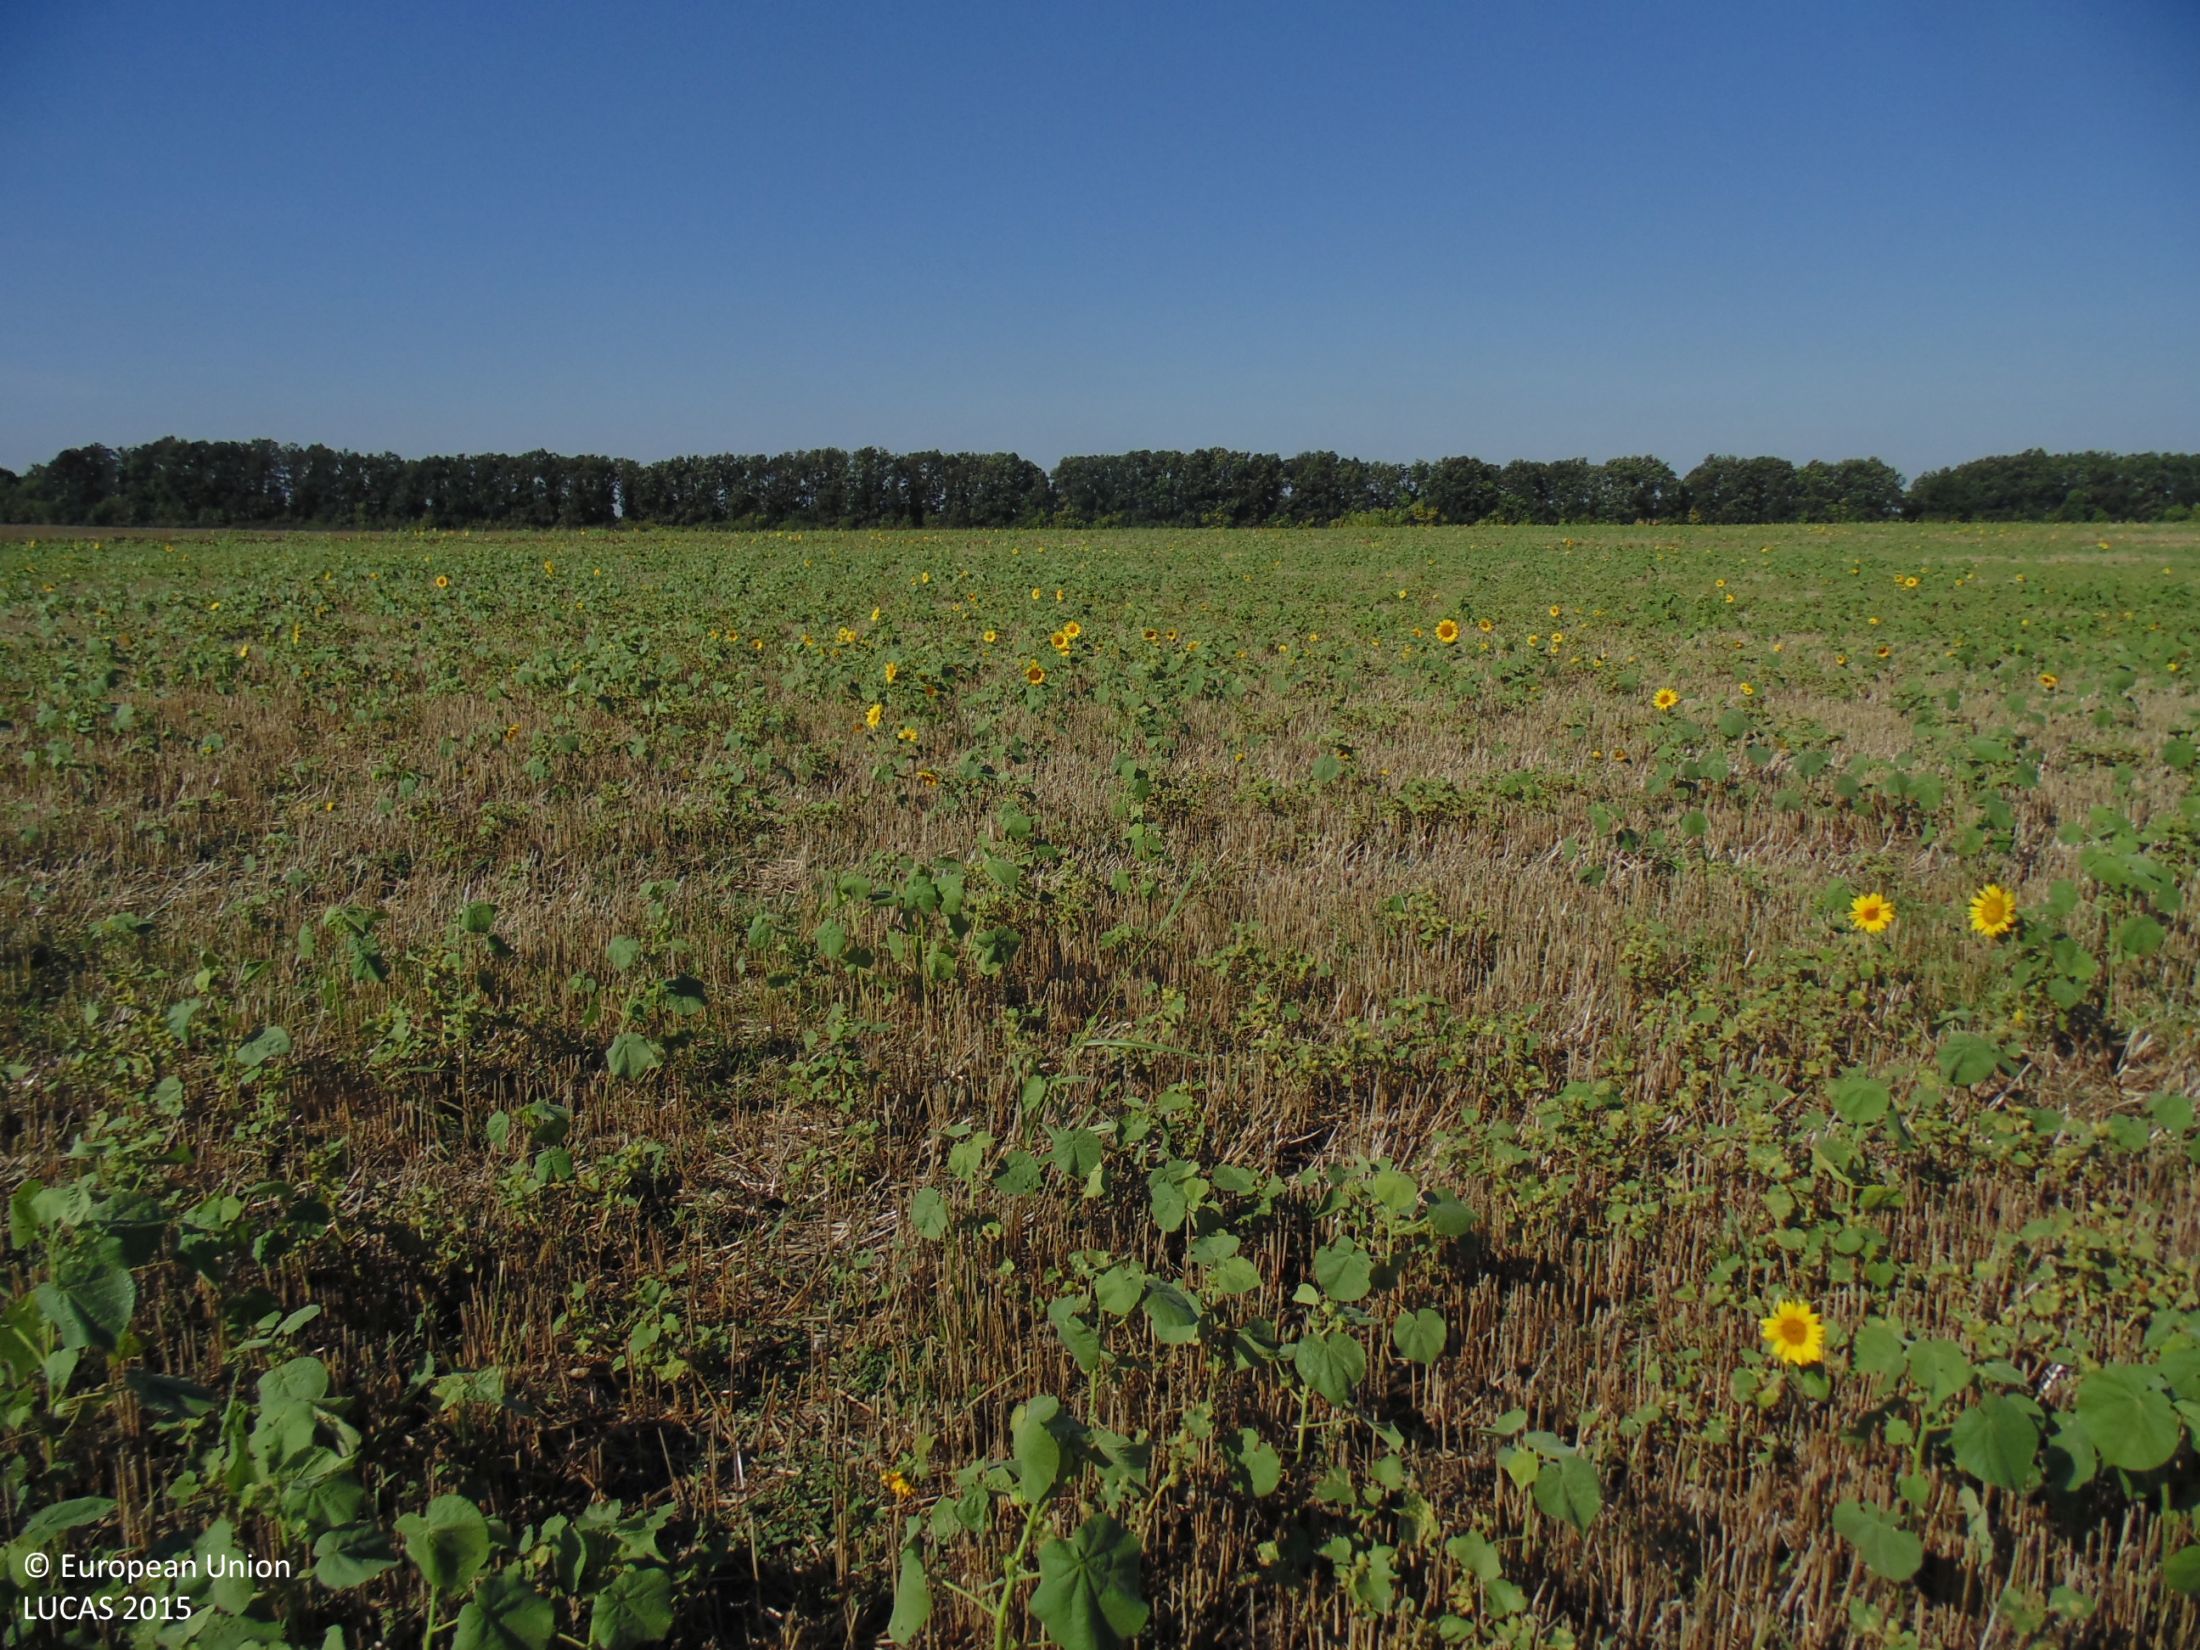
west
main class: Cropland
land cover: Common wheat
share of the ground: 10 - 25 %
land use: Agriculture (excluding fallow land and kitchen gardens)
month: September
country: BG
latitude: 44.0380
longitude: 27.0078
